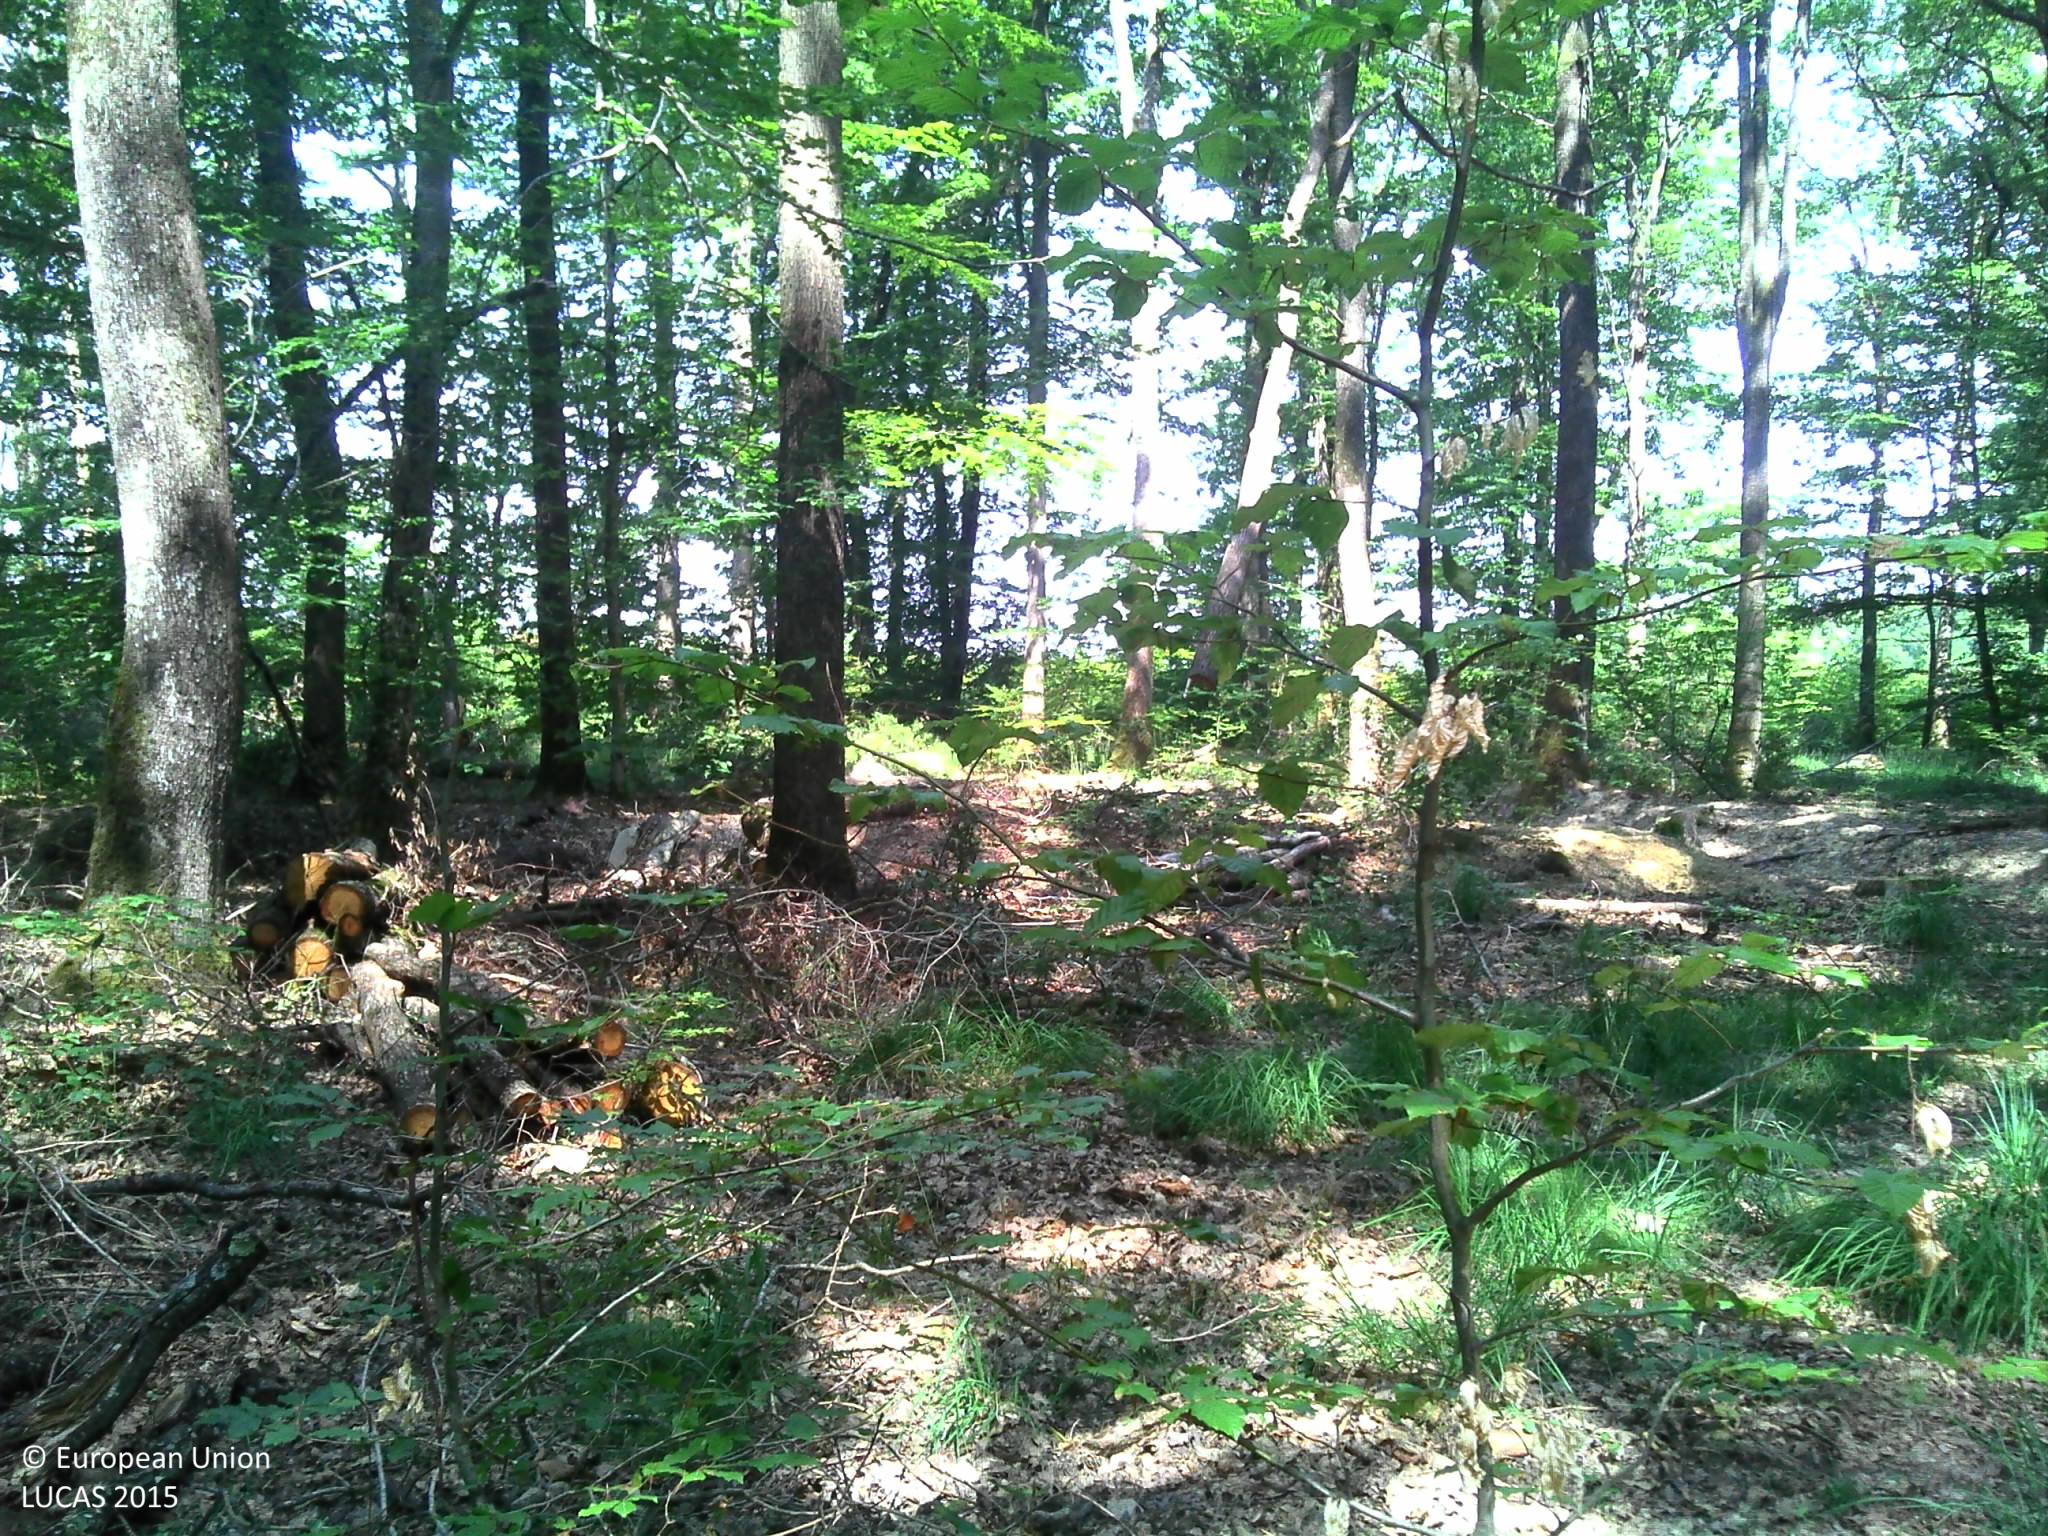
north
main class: Woodland
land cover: Broadleaved woodland
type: mesophytic deciduous forest
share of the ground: > 75 %
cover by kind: broadleaved forest trees 90 %, herbaceous plants 5 %, lichens and mosses 5 %
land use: Forestry
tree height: > 5 m
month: August
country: FR
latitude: 46.6811
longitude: 2.7134
